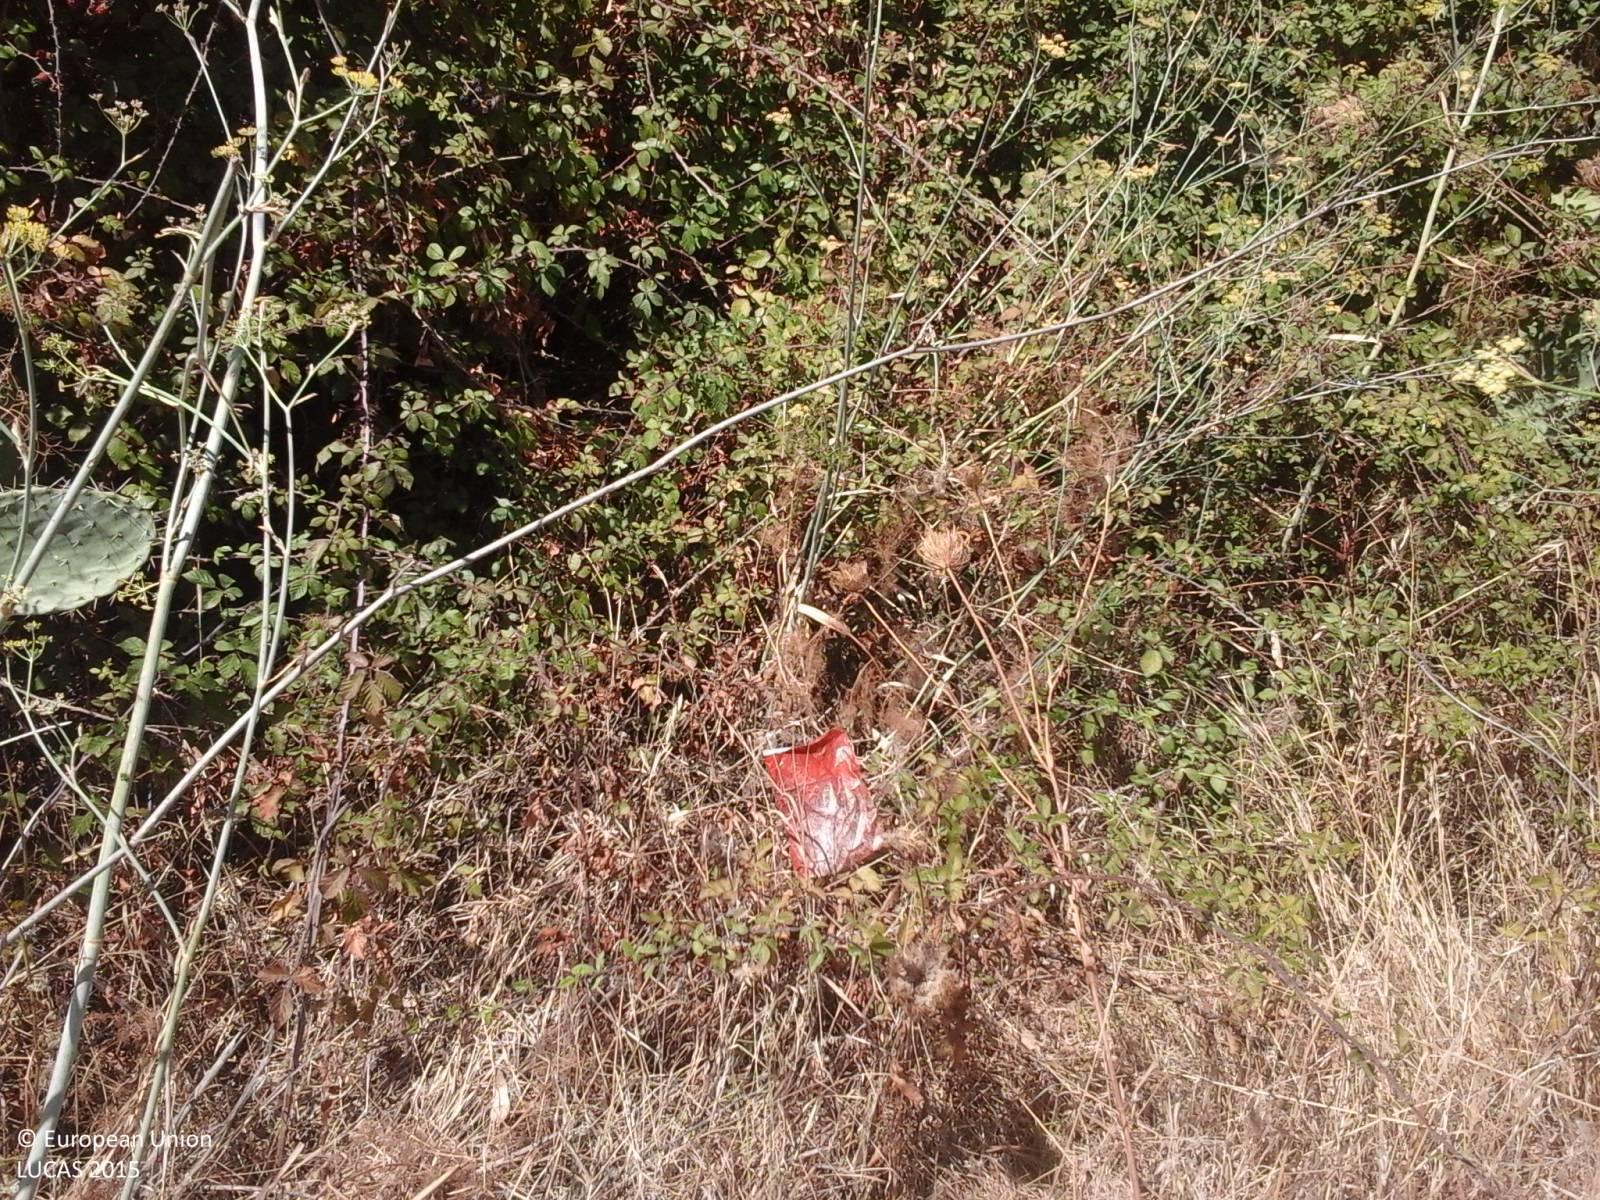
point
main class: Grassland
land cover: Grassland without tree/shrub cover
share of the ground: > 75 %
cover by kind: herbaceous plants 100 %
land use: Agriculture (excluding fallow land and kitchen gardens)
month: August
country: IT
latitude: 39.3723
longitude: 8.7885
